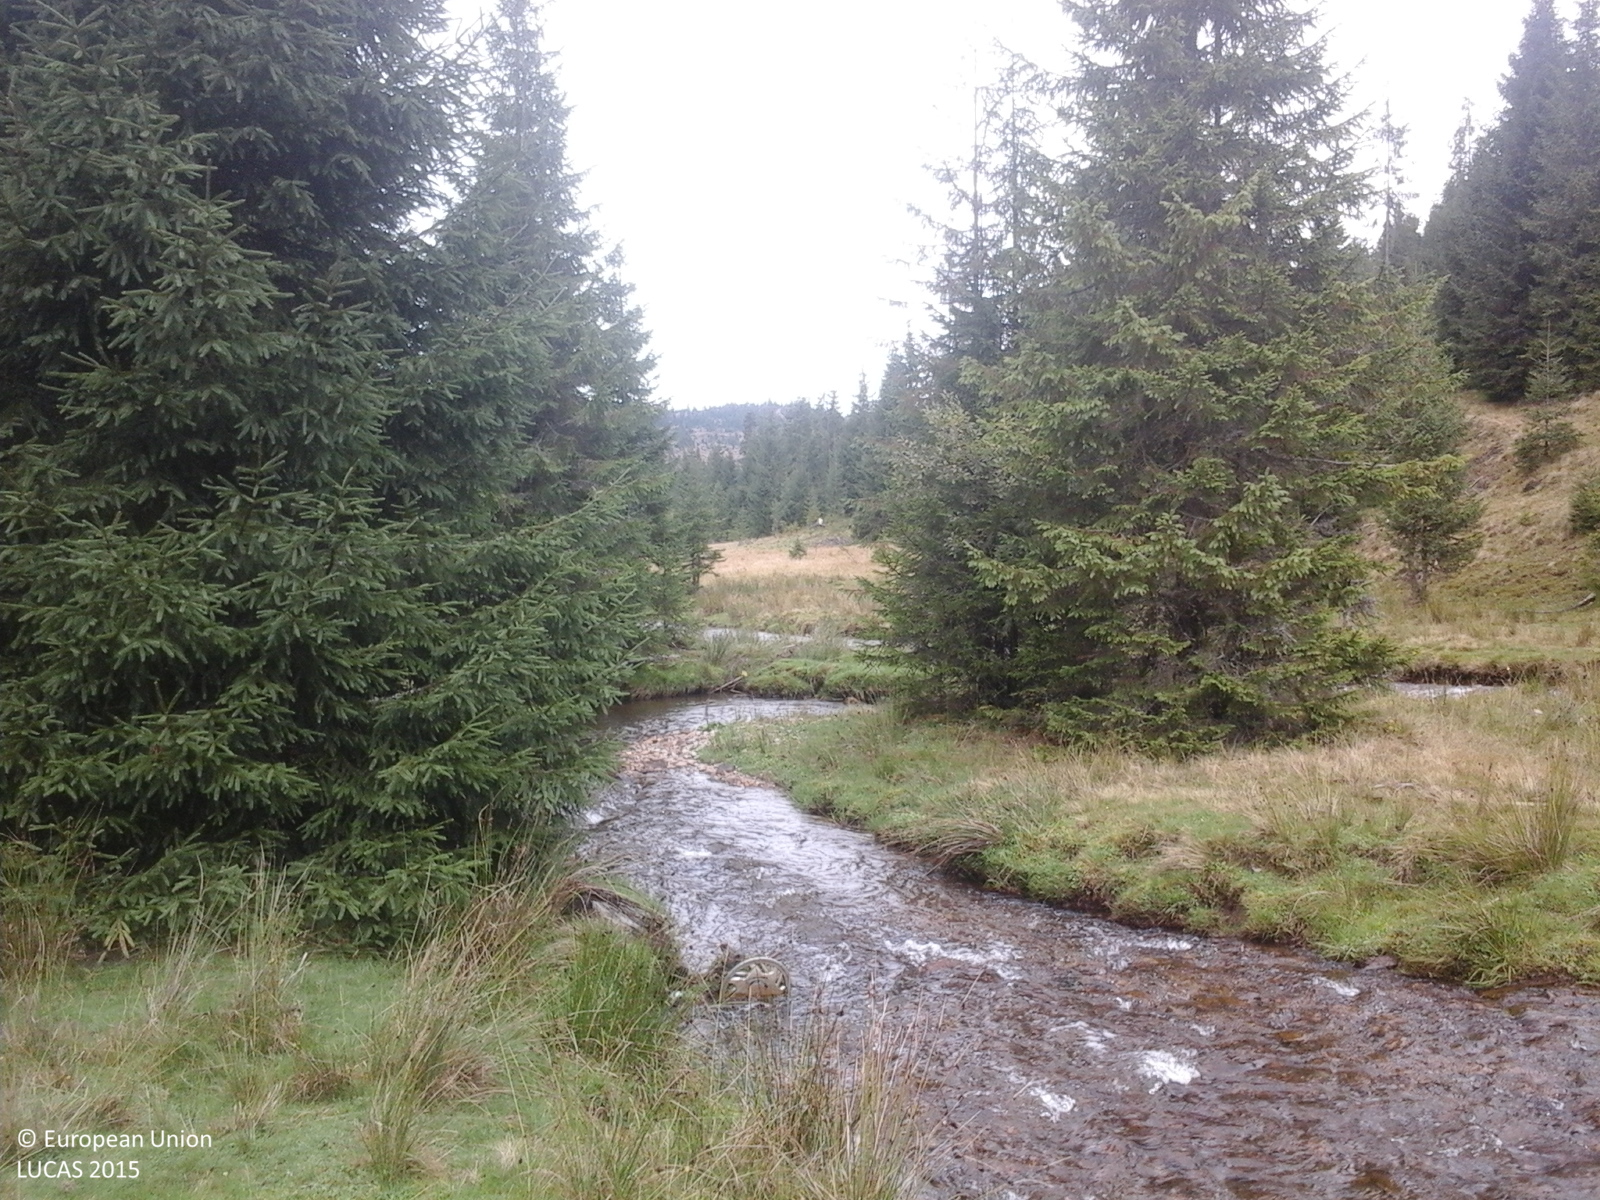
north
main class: Woodland
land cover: Spruce dominated coniferous woodland
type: alpine coniferous forest
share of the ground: > 75 %
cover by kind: coniferous forest trees 100 %
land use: Forestry
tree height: > 5 m
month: September
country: RO
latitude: 46.5698
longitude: 23.0421
